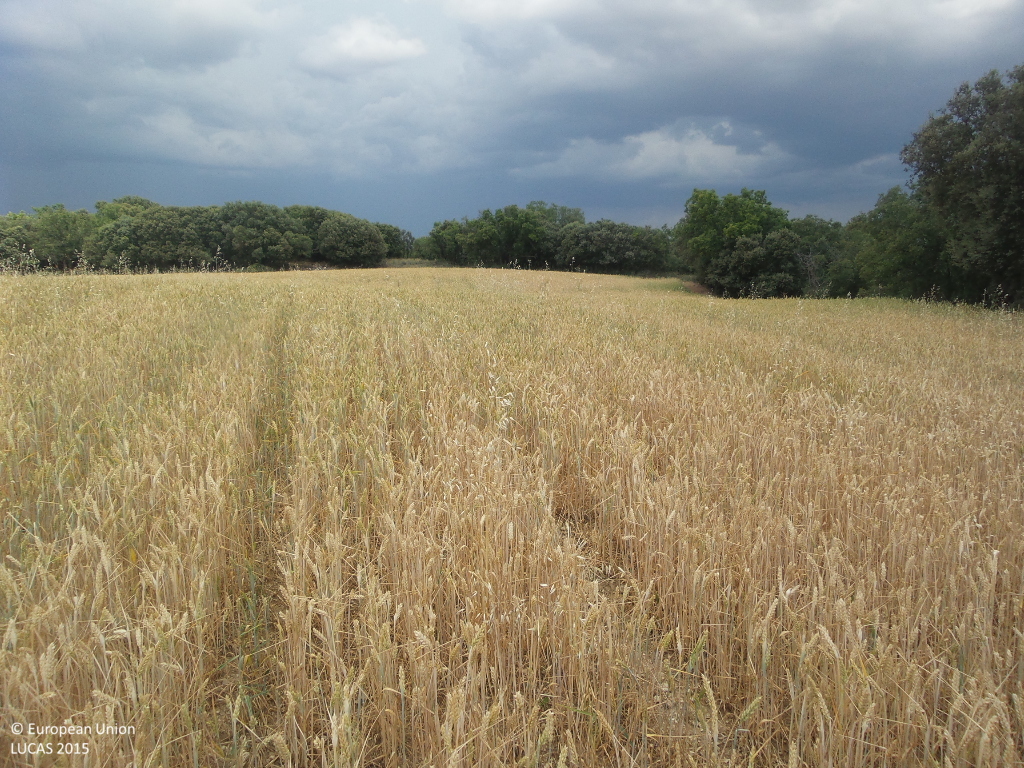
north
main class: Cropland
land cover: Common wheat
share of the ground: > 75 %
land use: Agriculture (excluding fallow land and kitchen gardens)
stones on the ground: < 10 %
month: June
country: ES
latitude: 41.4445
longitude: -2.7370
